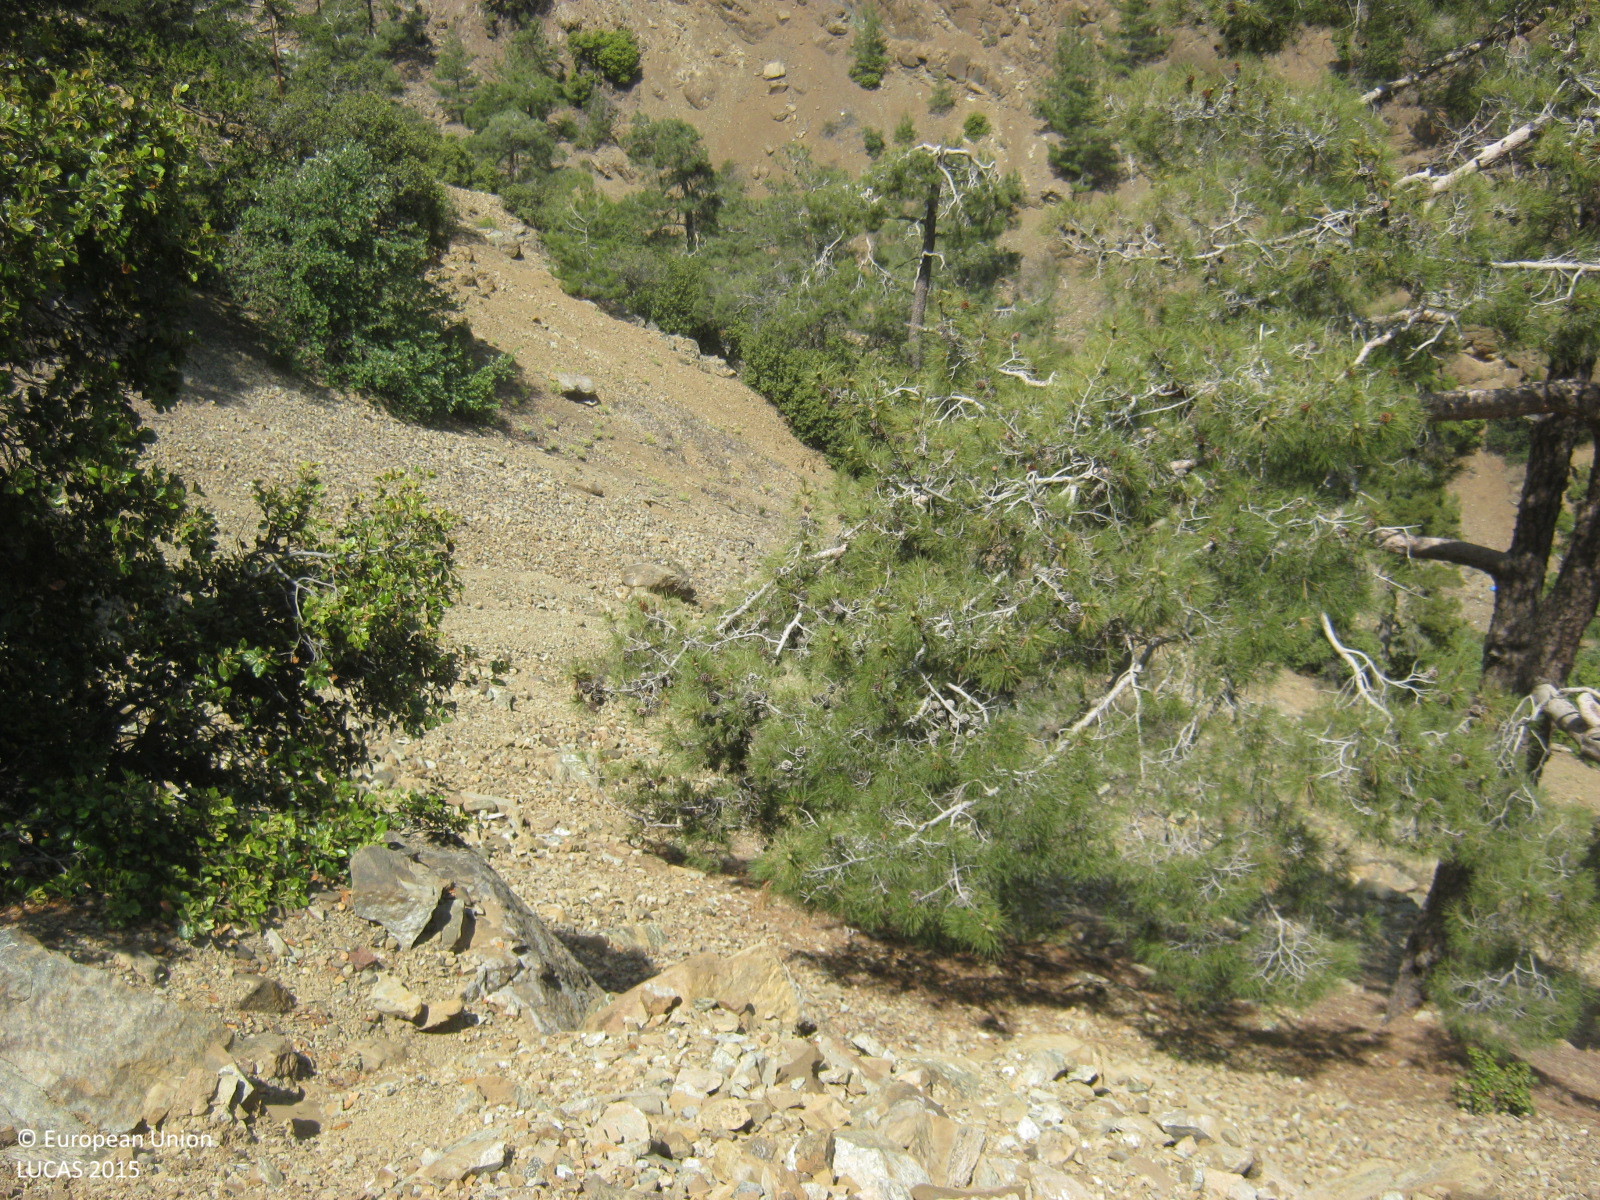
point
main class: Woodland
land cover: Pine dominated coniferous woodland
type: coniferous forest of the mediterranean region
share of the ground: 10 - 25 %
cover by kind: unconsolidated bare surface 65 %, coniferous forest trees 15 %, shrubs 10 %, consolidated bare surface 10 %
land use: Forestry
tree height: > 5 m
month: June
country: CY
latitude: 34.9585
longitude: 32.8693
